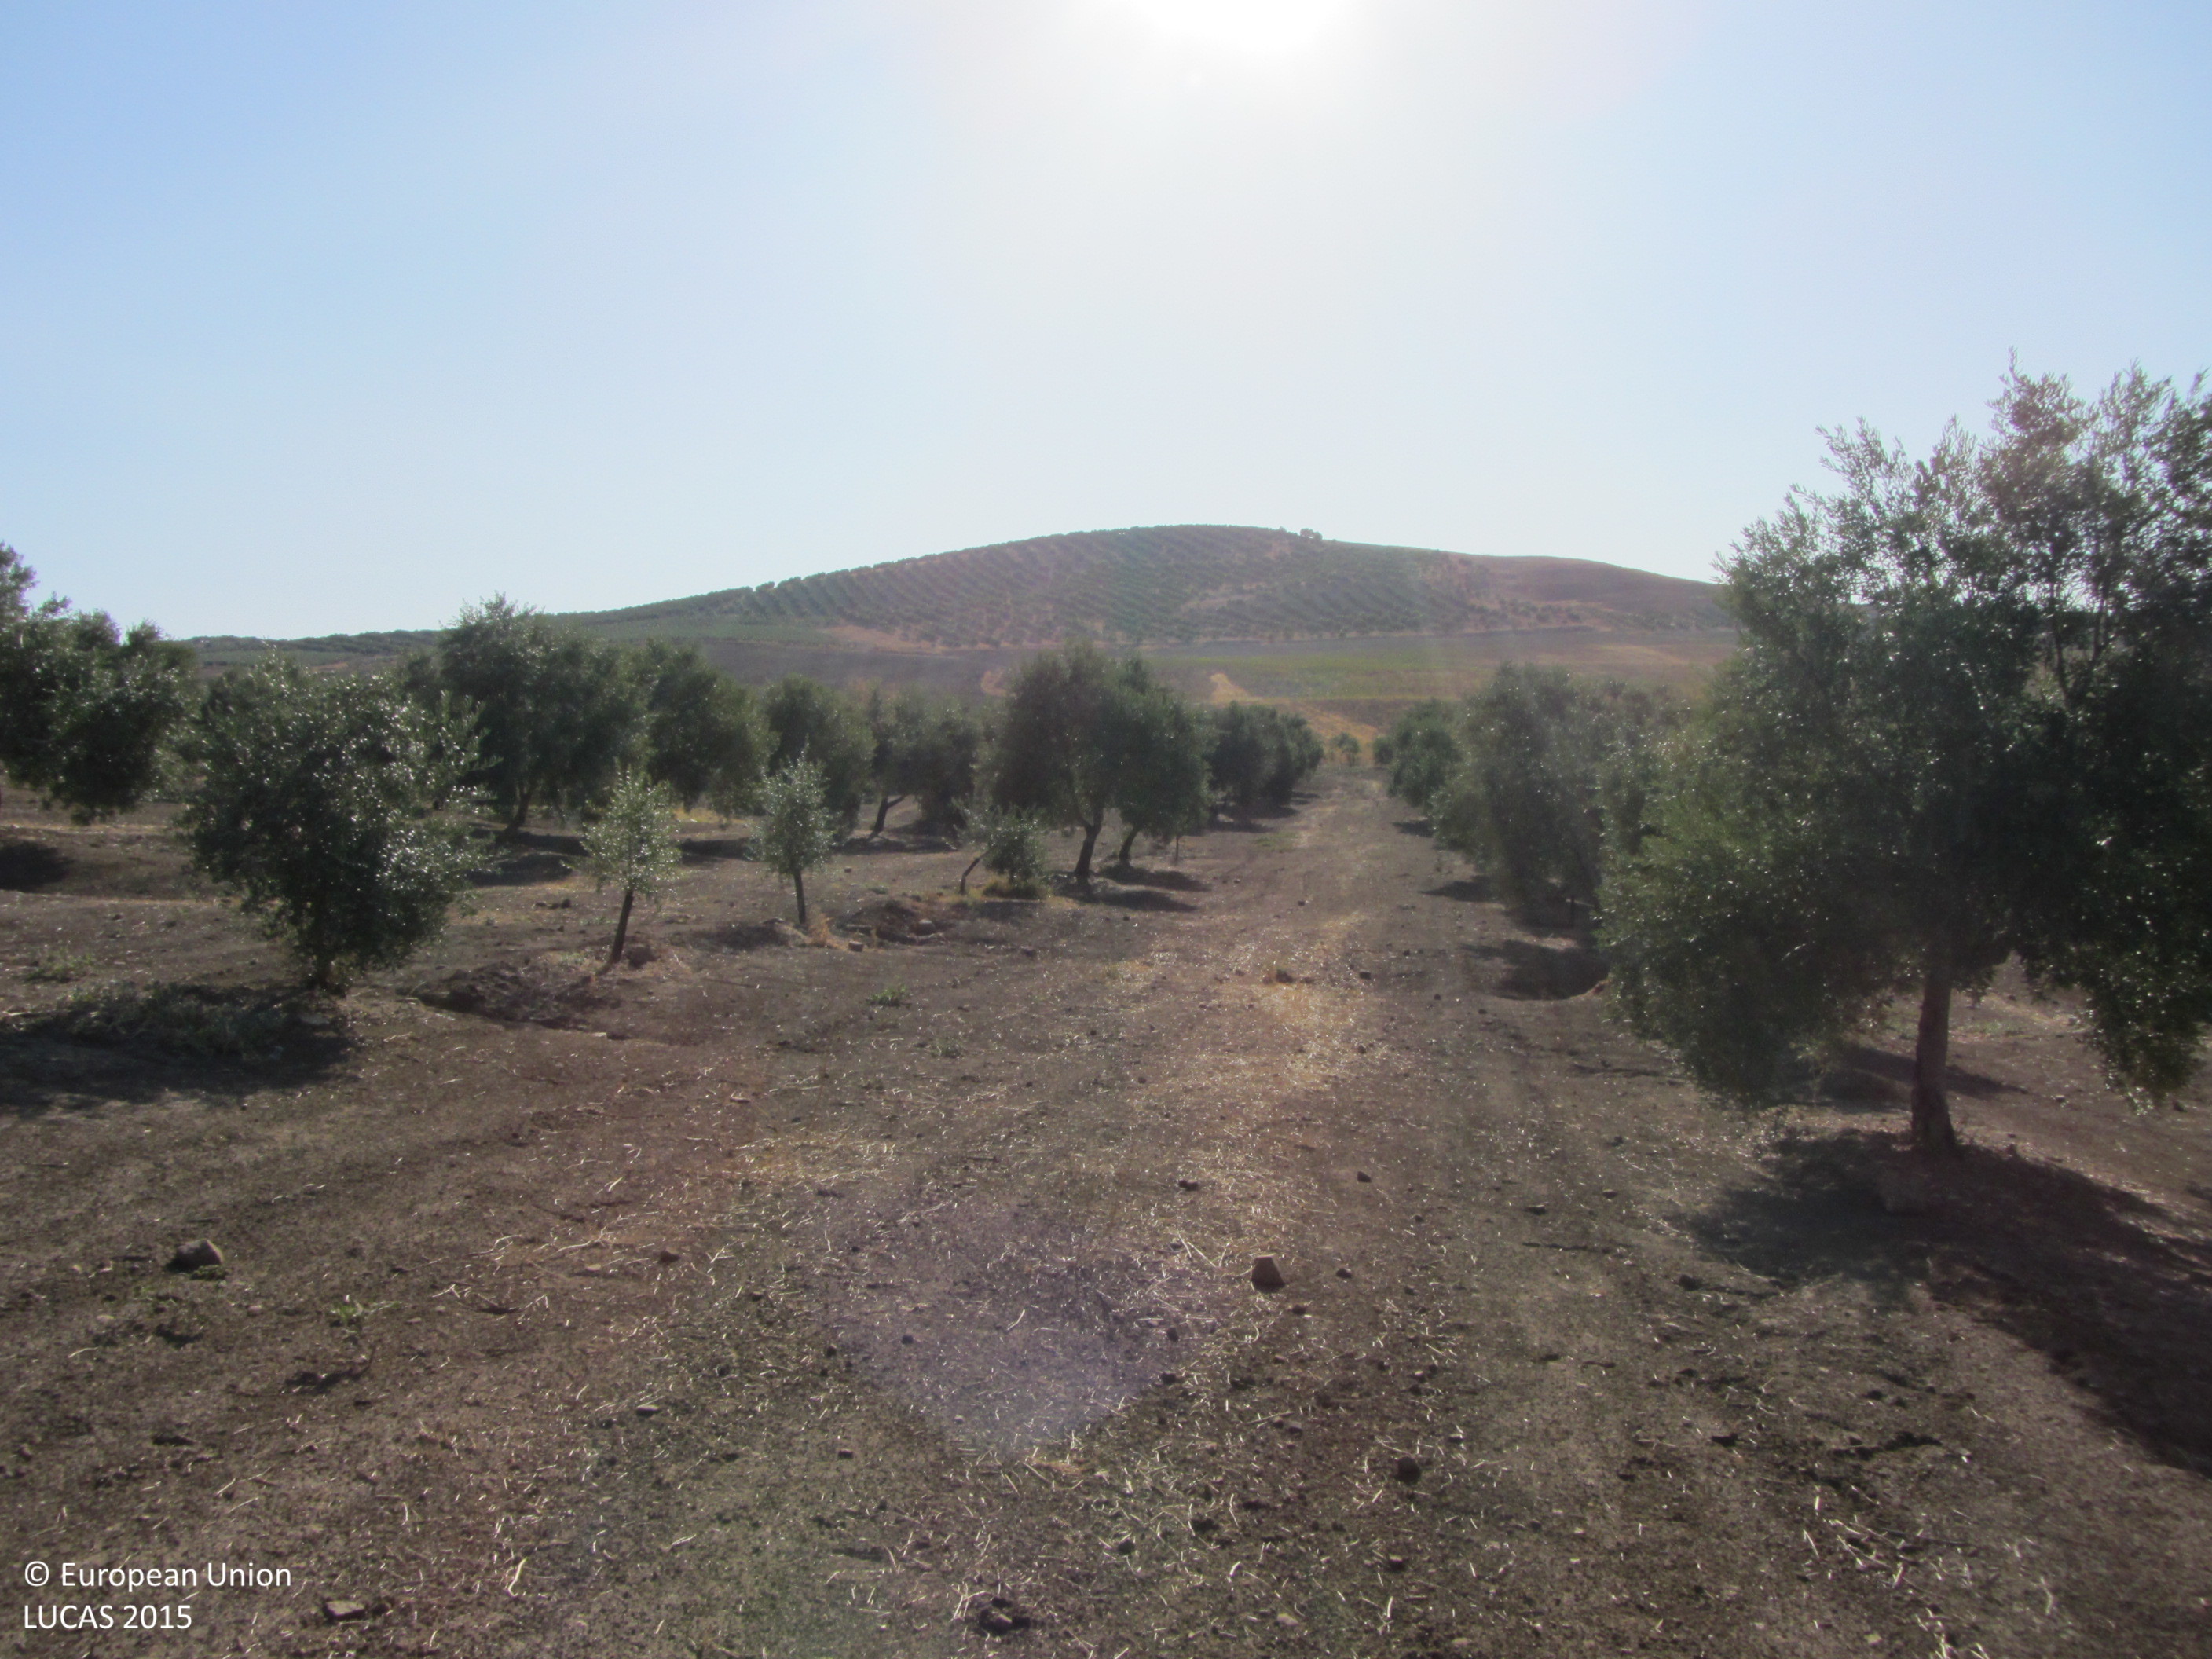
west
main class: Cropland
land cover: Olive groves
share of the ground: 25 - 50 %
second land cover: Other bare soil
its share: > 75 %
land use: Agriculture (excluding fallow land and kitchen gardens)
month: July
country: ES
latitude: 37.9405
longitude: -3.8519
